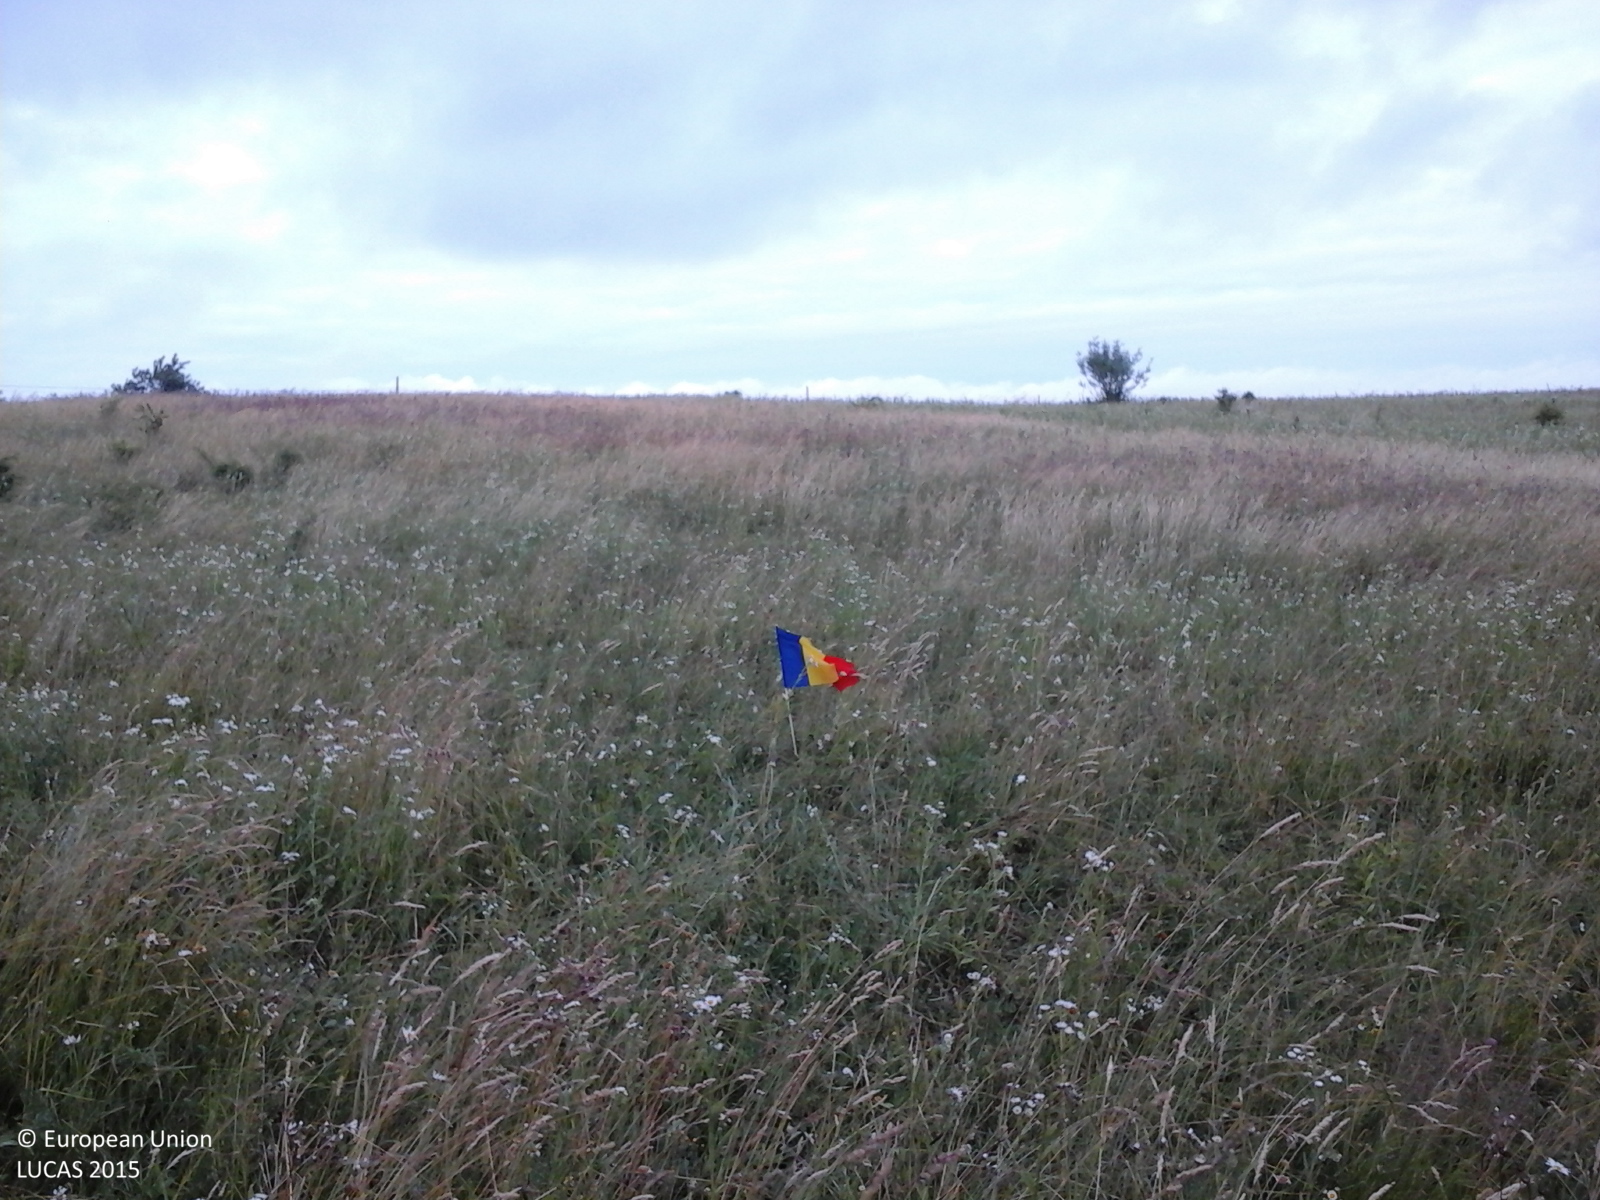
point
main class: Grassland
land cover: Grassland without tree/shrub cover
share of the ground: > 75 %
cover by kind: herbaceous plants 100 %
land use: Agriculture (excluding fallow land and kitchen gardens)
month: June
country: RO
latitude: 47.9694
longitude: 25.9498
